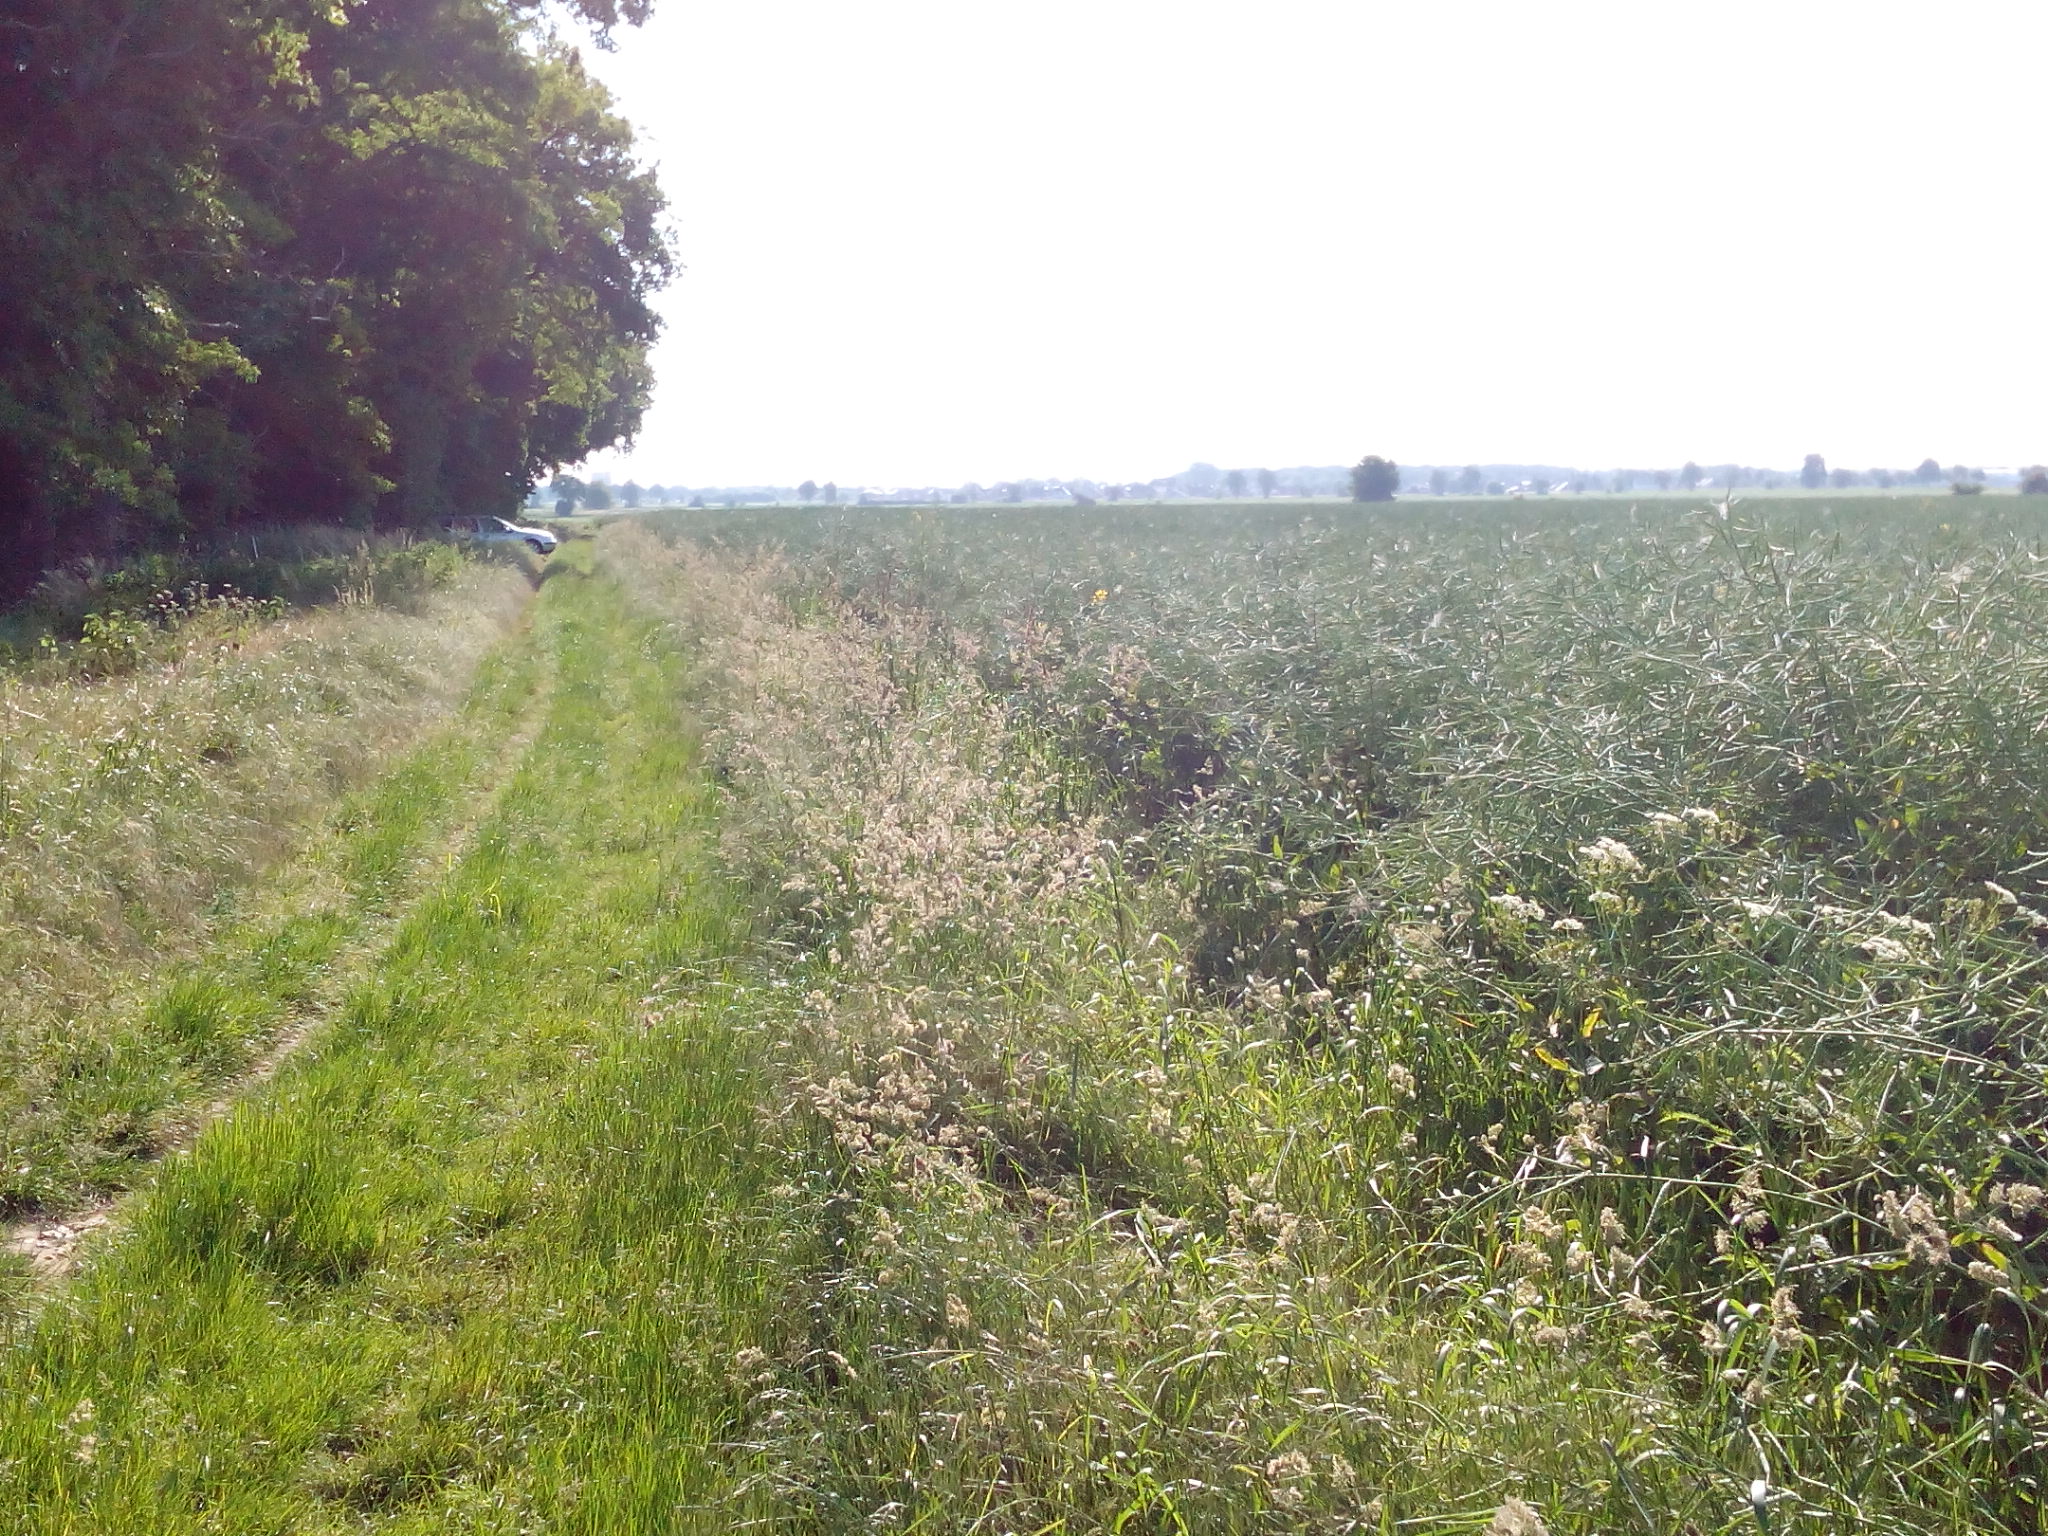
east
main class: Cropland
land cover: Rape and turnip rape
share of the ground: > 75 %
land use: Agriculture (excluding fallow land and kitchen gardens)
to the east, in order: Rape and turnip rape; Grass margins; Paved roads, cycling and walking lanes; Grass margins; Common wheat
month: June
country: DE
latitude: 52.3235
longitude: 9.9267
